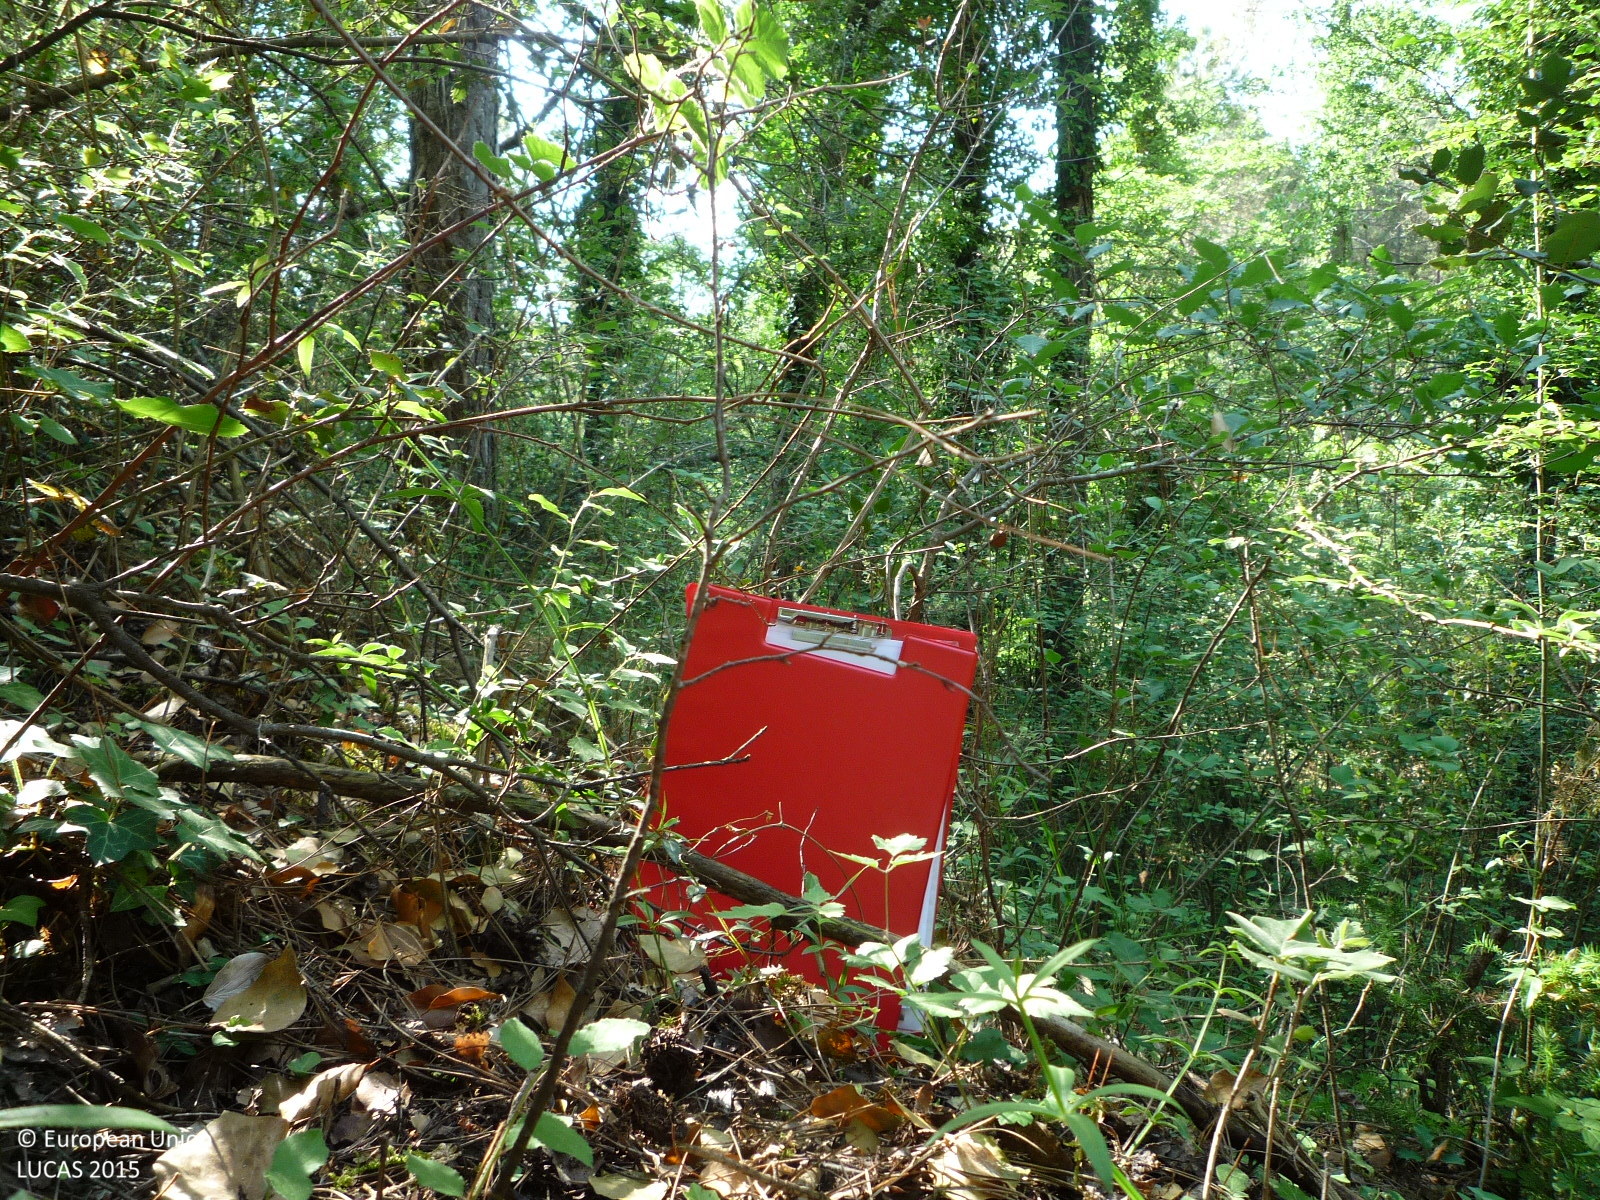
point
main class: Woodland
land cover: Pine dominated mixed woodland
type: coniferous forest of the mediterranean region
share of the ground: > 75 %
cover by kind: coniferous forest trees 70 %, broadleaved forest trees 30 %
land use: Semi-natural and natural areas not in use
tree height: > 5 m
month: May
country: ES
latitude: 41.9016
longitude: 1.9984
